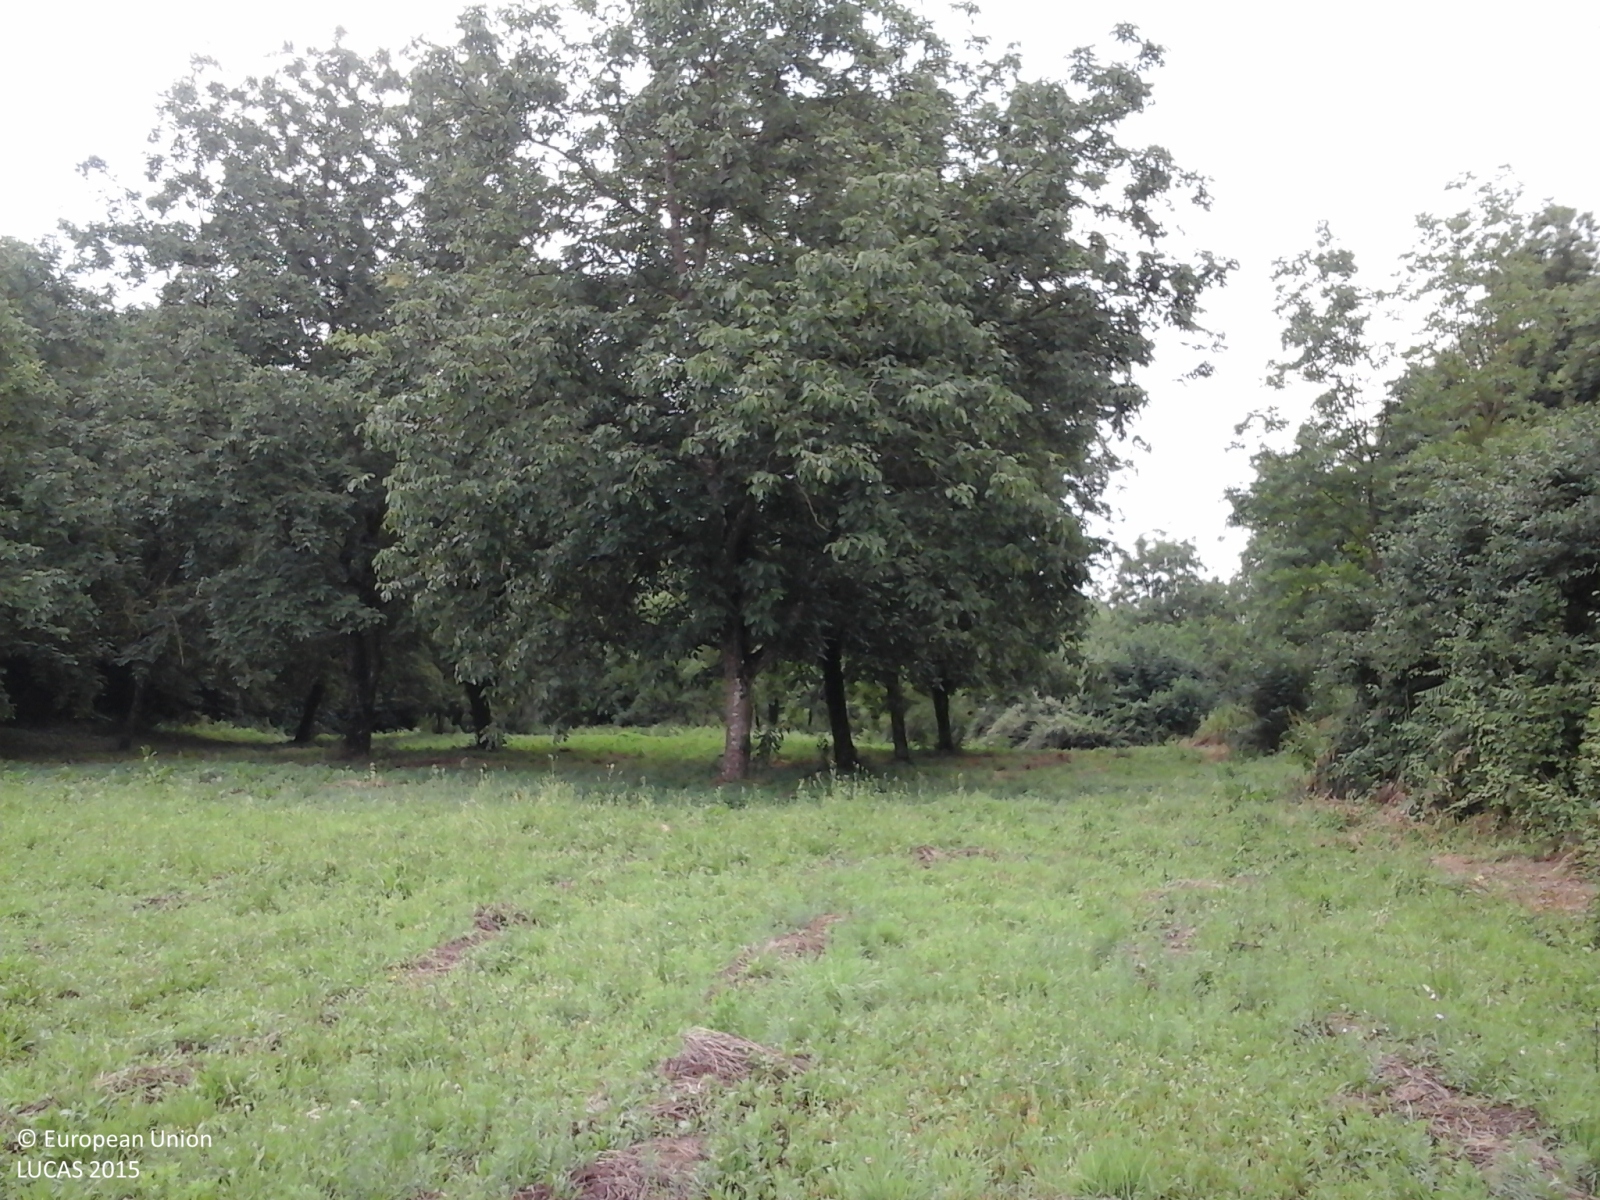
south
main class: Cropland
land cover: Temporary grasslands
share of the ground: > 75 %
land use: Agriculture (excluding fallow land and kitchen gardens)
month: June
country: IT
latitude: 41.8167
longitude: 12.9145
